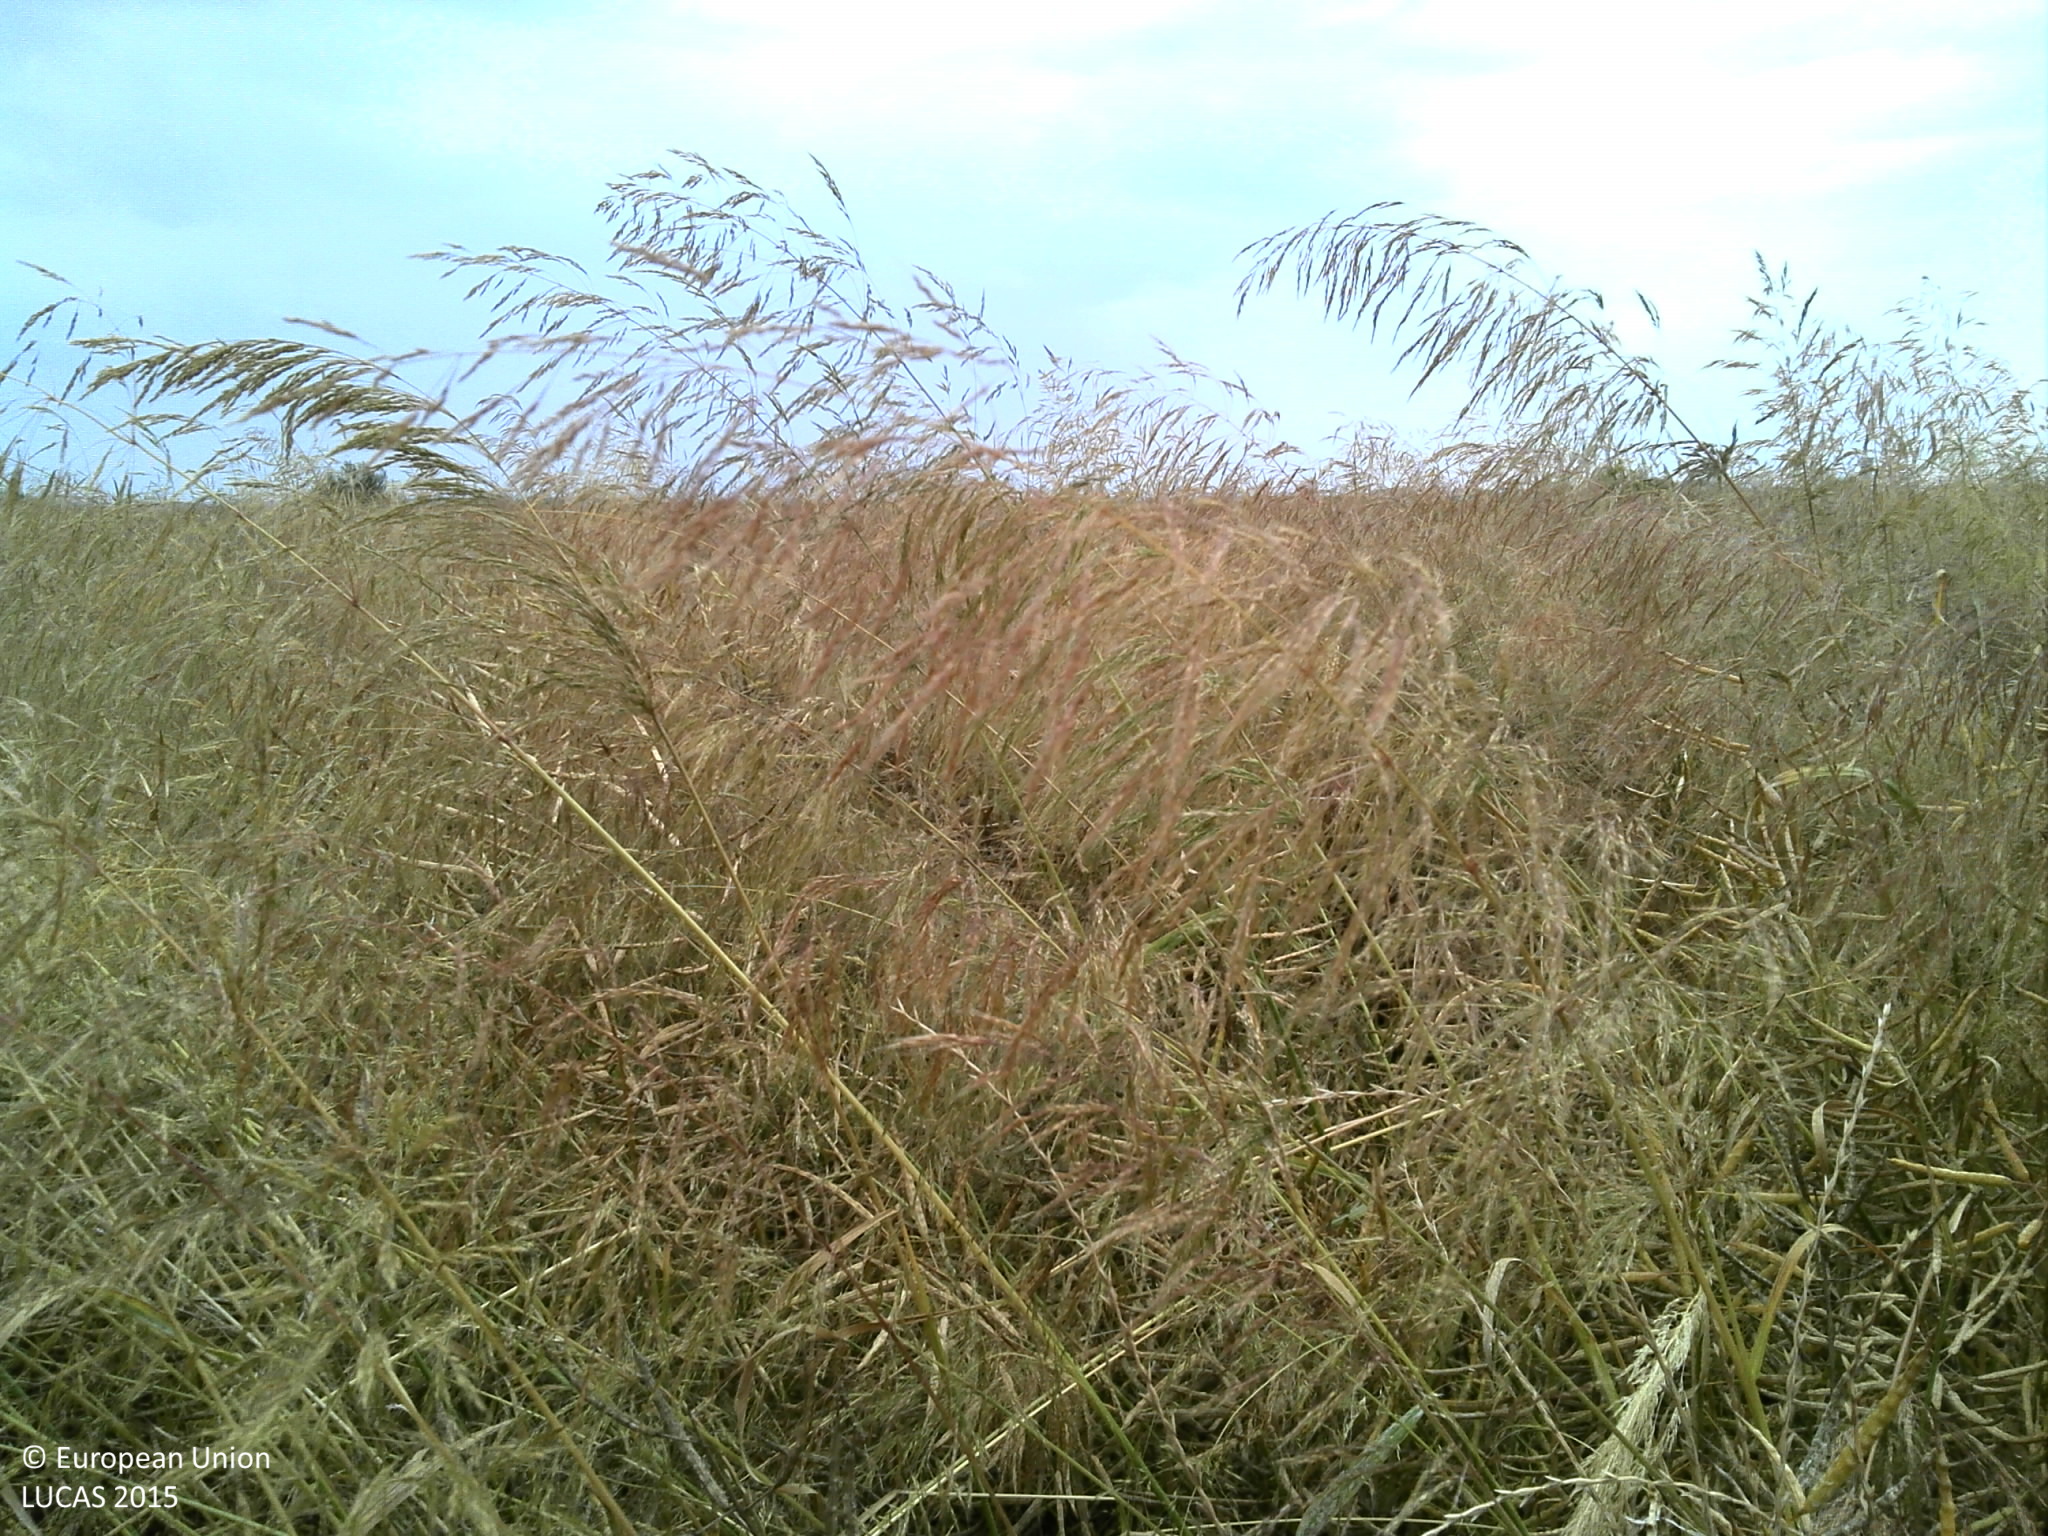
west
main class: Cropland
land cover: Rape and turnip rape
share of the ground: > 75 %
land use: Agriculture (excluding fallow land and kitchen gardens)
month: June
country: HR
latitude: 45.3470
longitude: 18.4418
